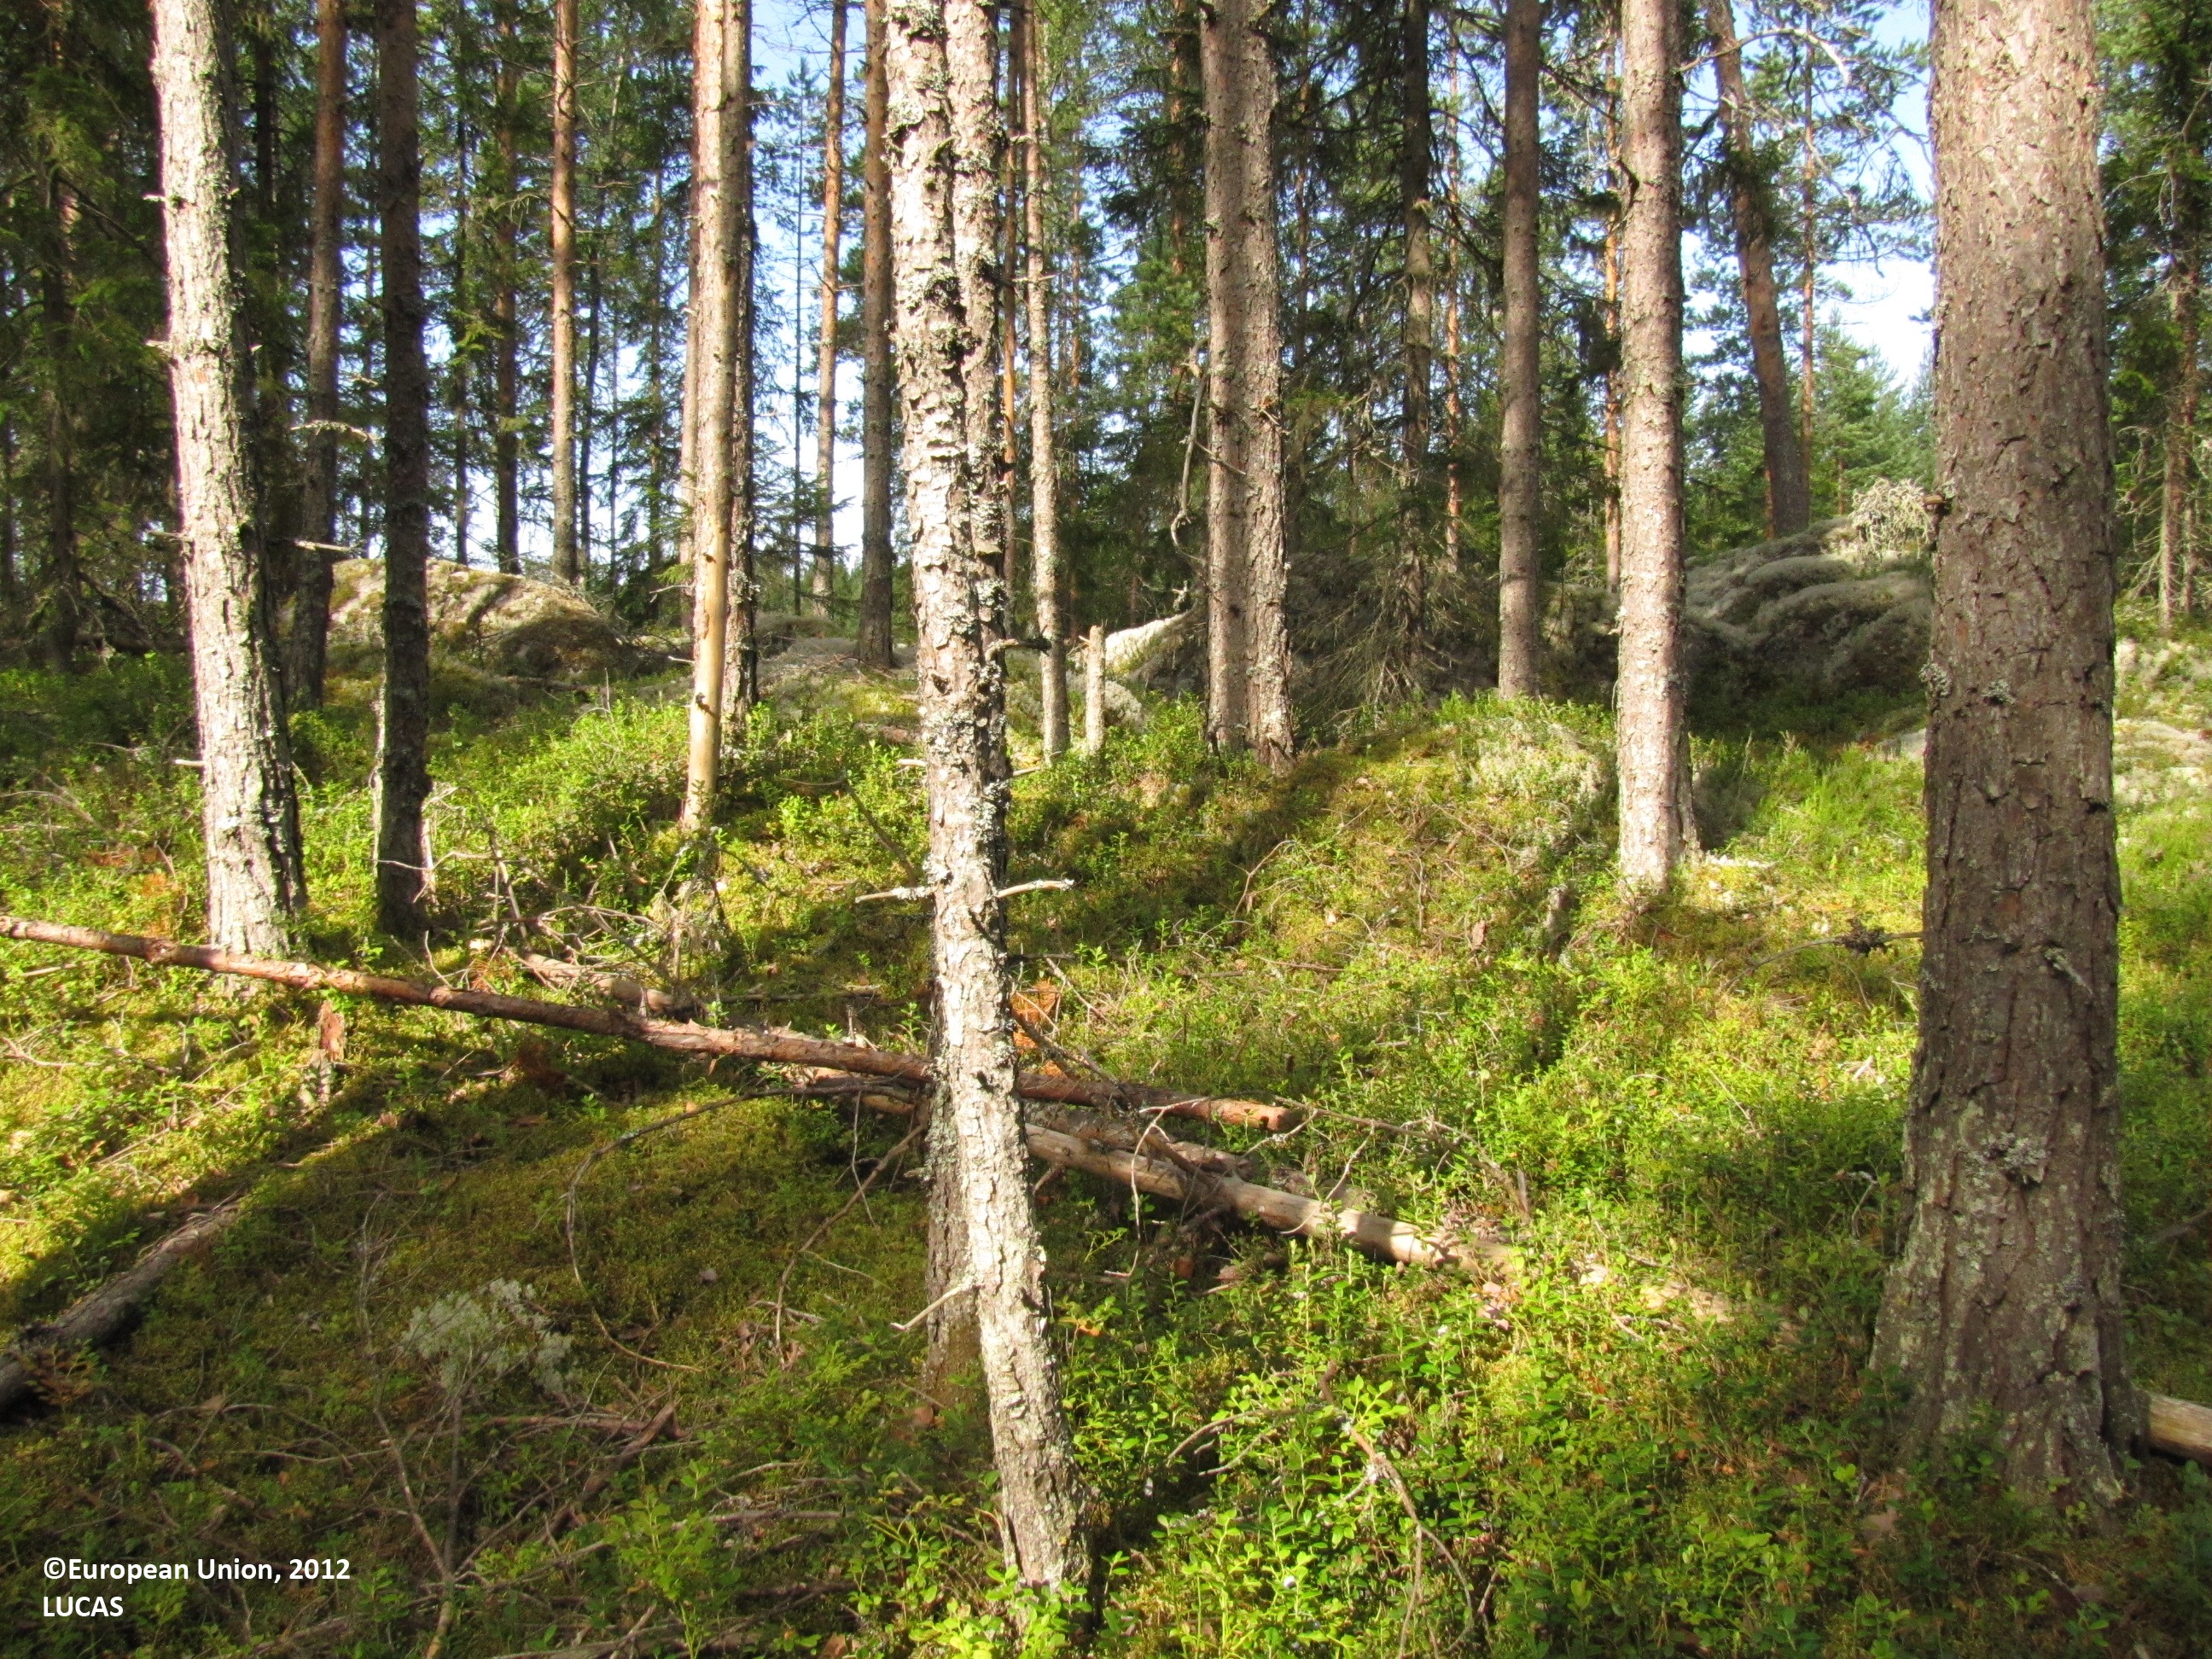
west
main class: Woodland
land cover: Other coniferous woodland
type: boreal forest
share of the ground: 50 - 75 %
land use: Forestry
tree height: > 5 m
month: August
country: FI
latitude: 61.8062
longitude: 23.2208
